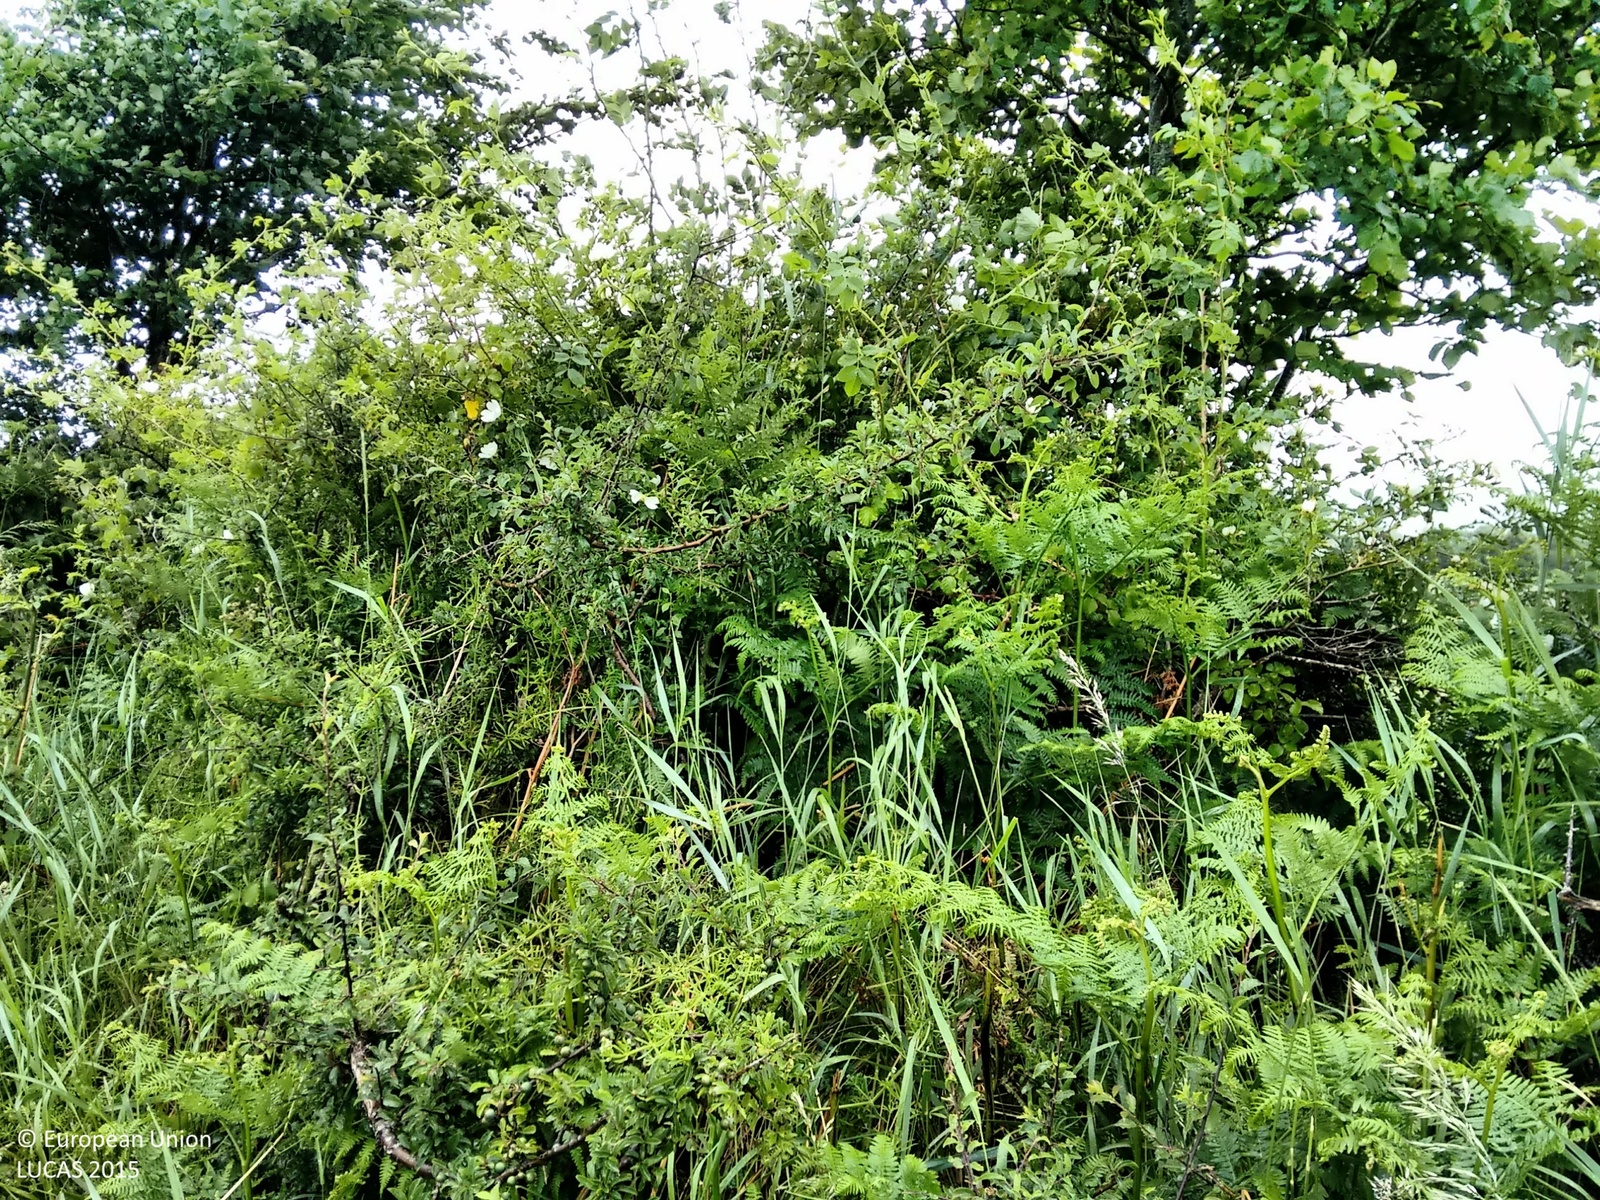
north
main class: Grassland
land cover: Grassland without tree/shrub cover
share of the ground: > 75 %
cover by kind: herbaceous plants 100 %
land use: Agriculture (excluding fallow land and kitchen gardens)
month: June
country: IE
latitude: 52.3741
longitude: -7.4763
